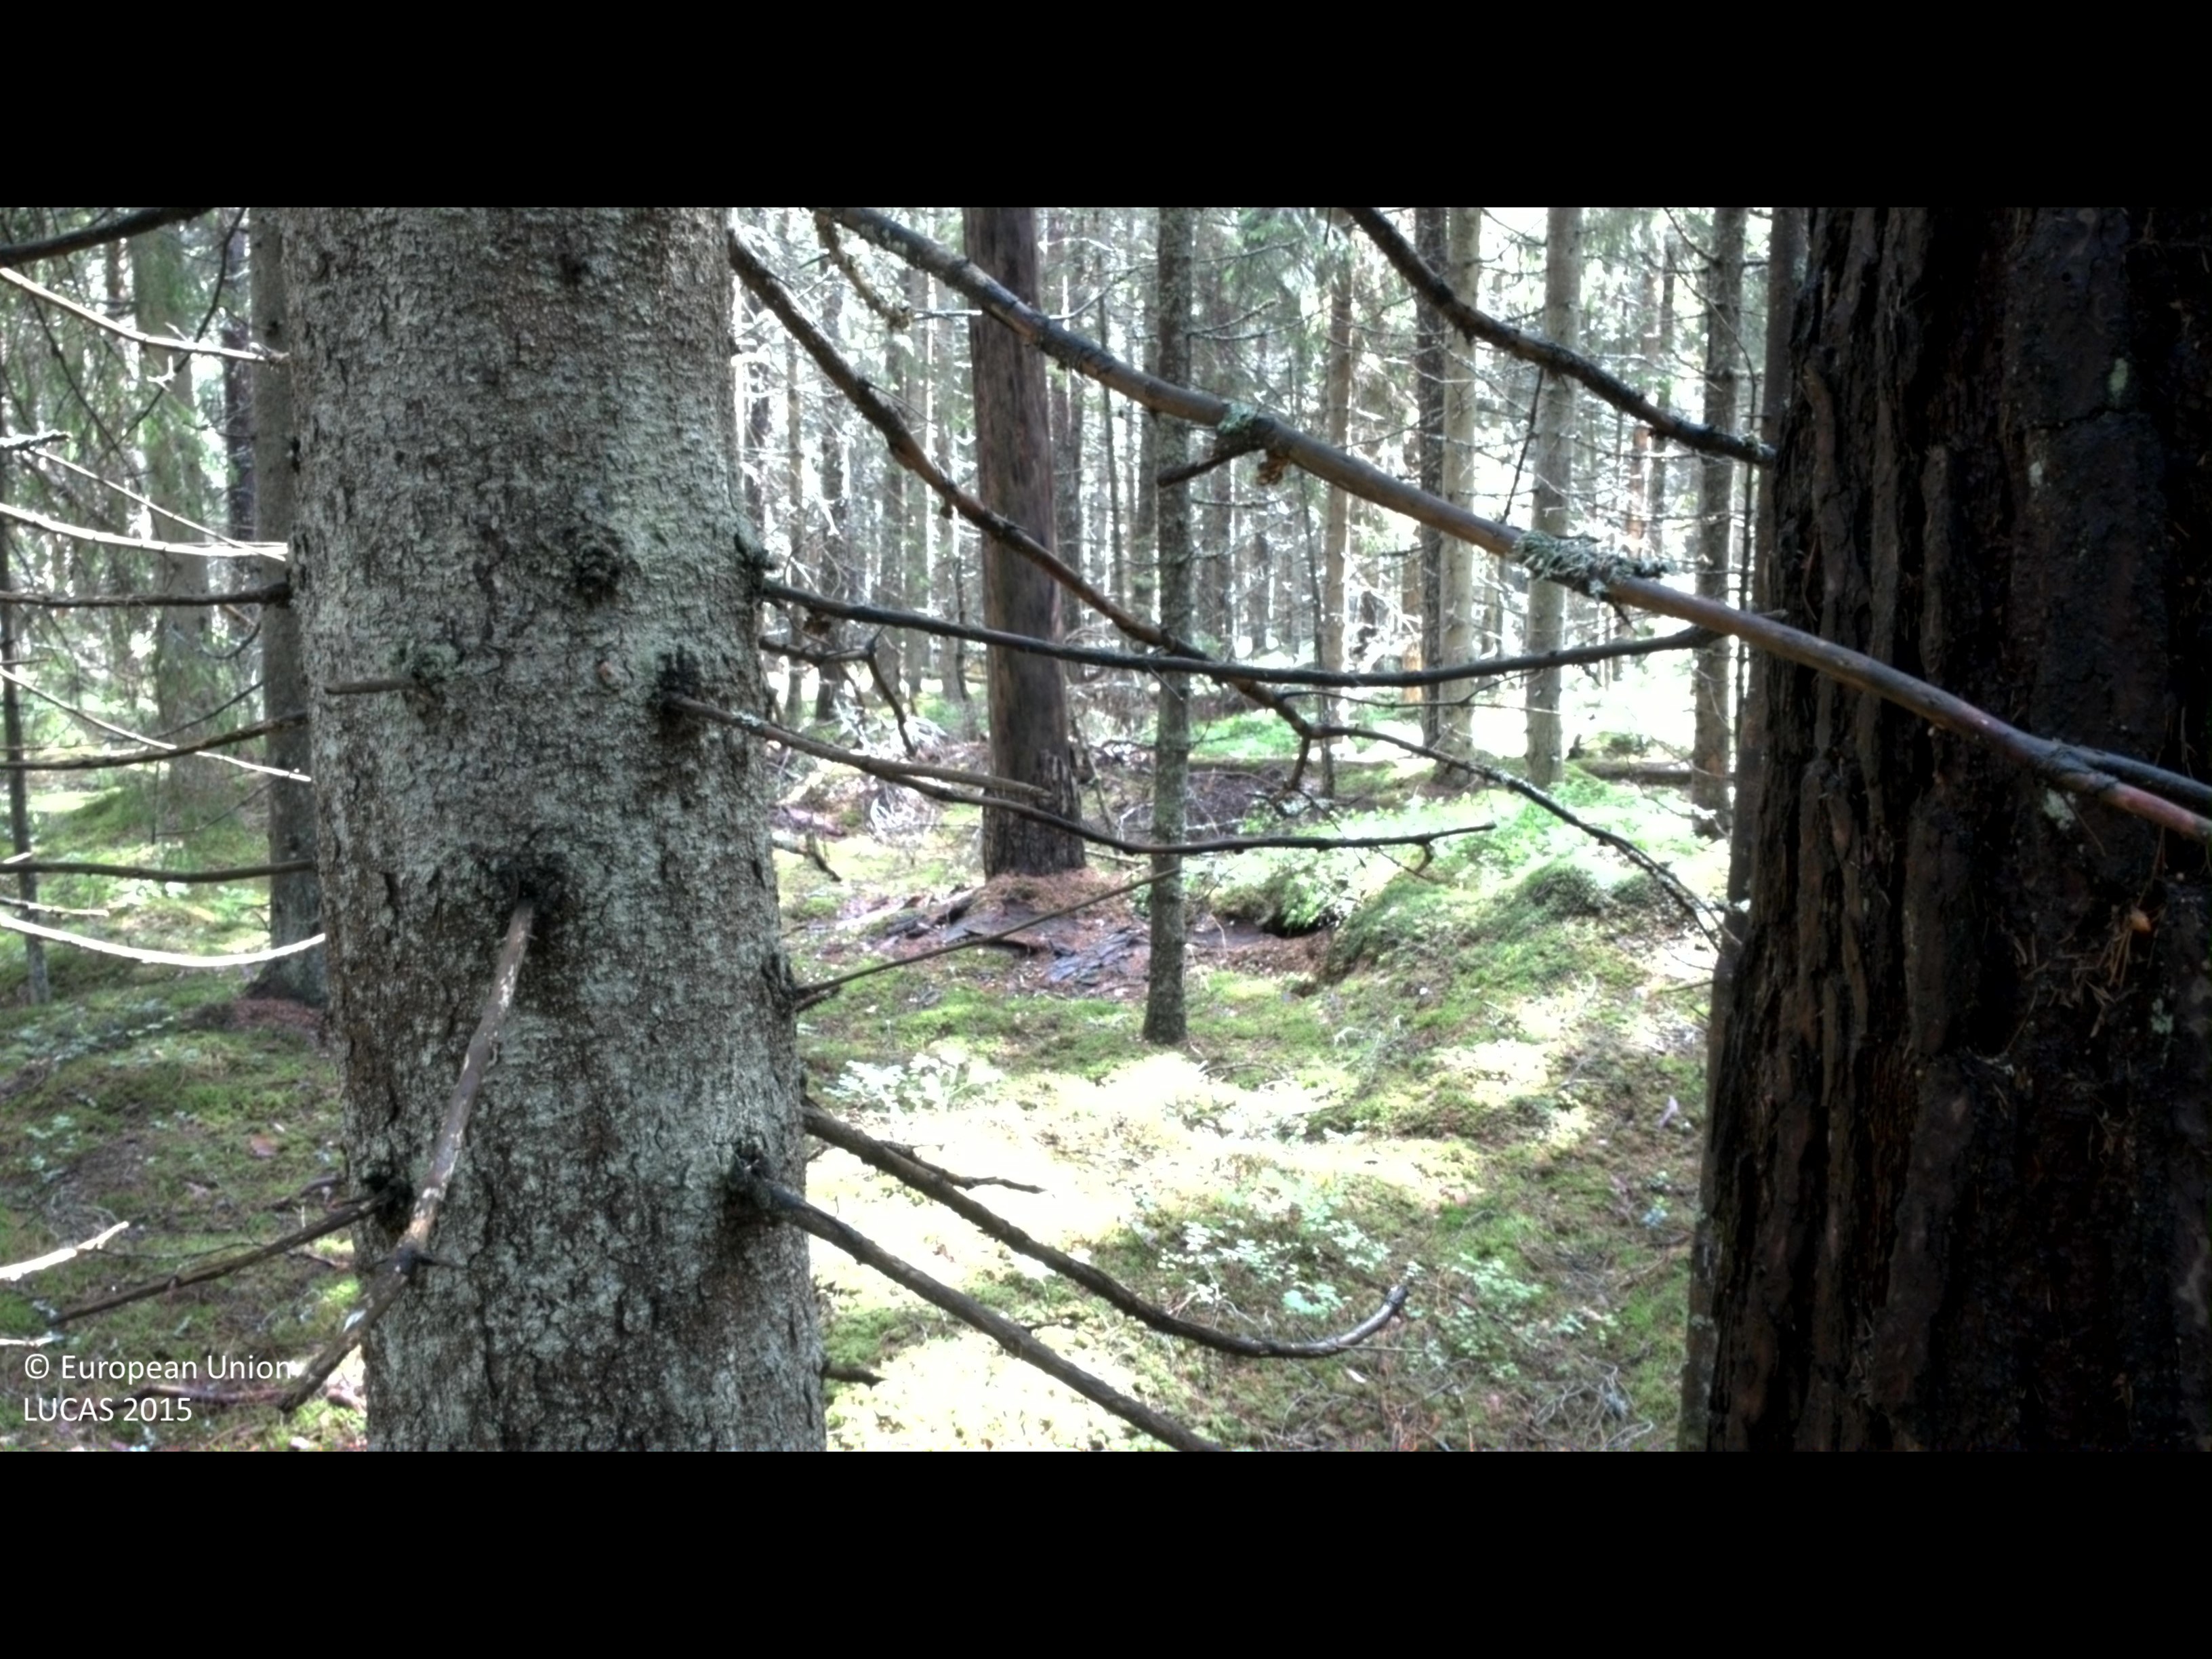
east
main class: Woodland
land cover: Spruce dominated coniferous woodland
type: boreal forest
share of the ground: > 75 %
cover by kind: coniferous forest trees 80 %, shrubs 10 %, lichens and mosses 10 %
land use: Forestry
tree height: > 5 m
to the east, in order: Spruce dominated coniferous woodland; Ditches and canals; Spruce dominated coniferous woodland; Shrubland with sparse tree cover; Spruce dominated coniferous woodland
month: June
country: SE
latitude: 58.0623
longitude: 16.1150
